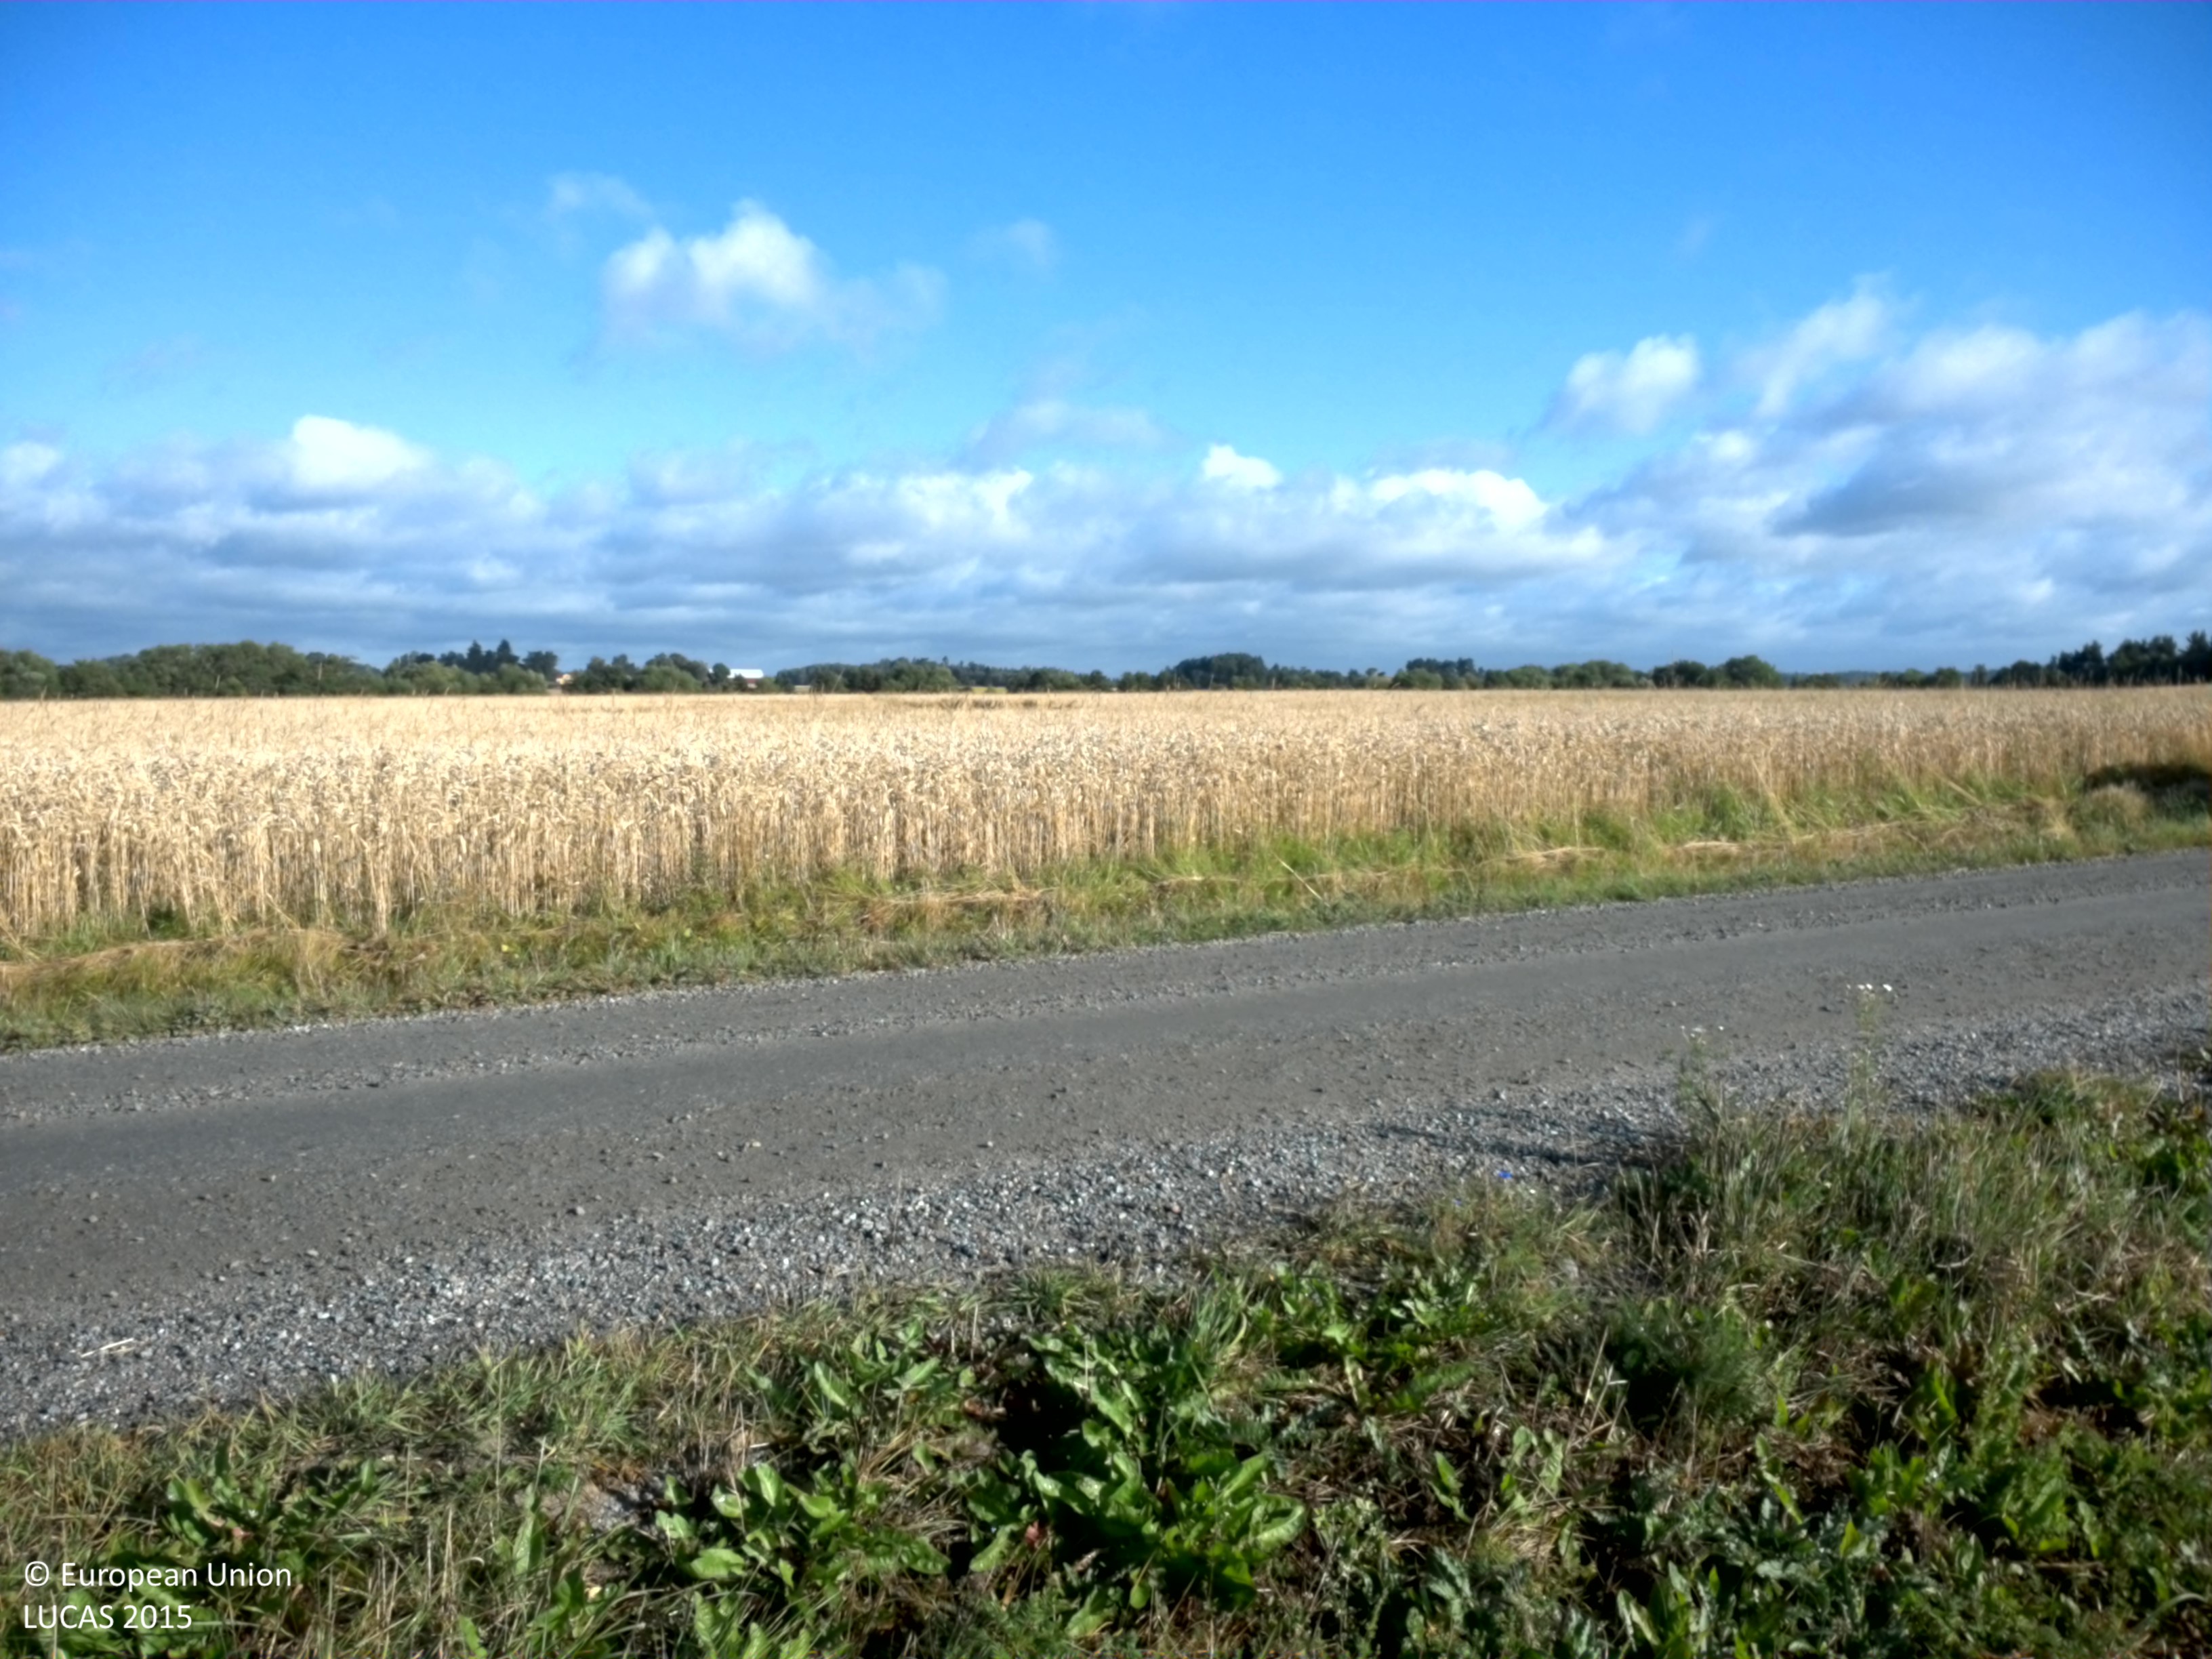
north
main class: Cropland
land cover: Rye
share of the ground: > 75 %
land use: Agriculture (excluding fallow land and kitchen gardens)
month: August
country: SE
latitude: 59.7311
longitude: 17.0897
